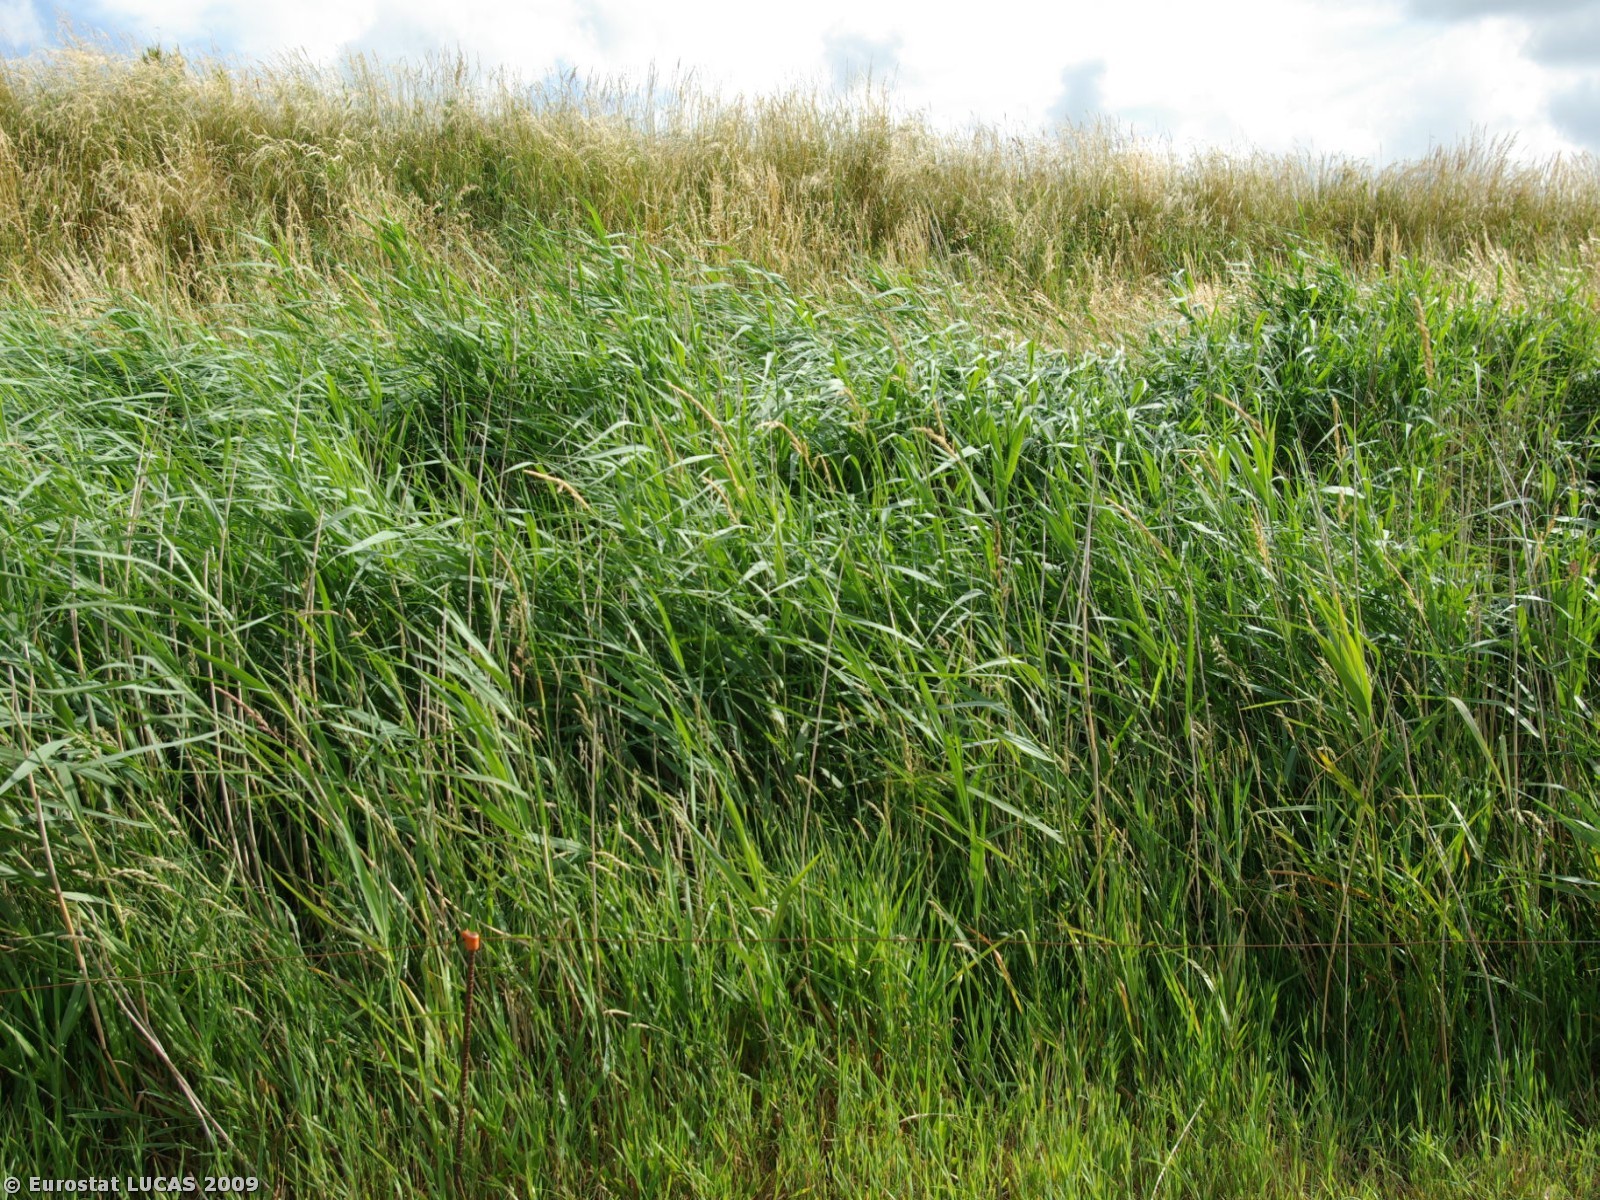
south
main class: Grassland
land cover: Grassland without tree/shrub cover
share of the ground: > 75 %
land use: Agriculture (excluding fallow land and kitchen gardens)
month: July
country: DK
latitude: 54.9247
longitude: 8.8930
